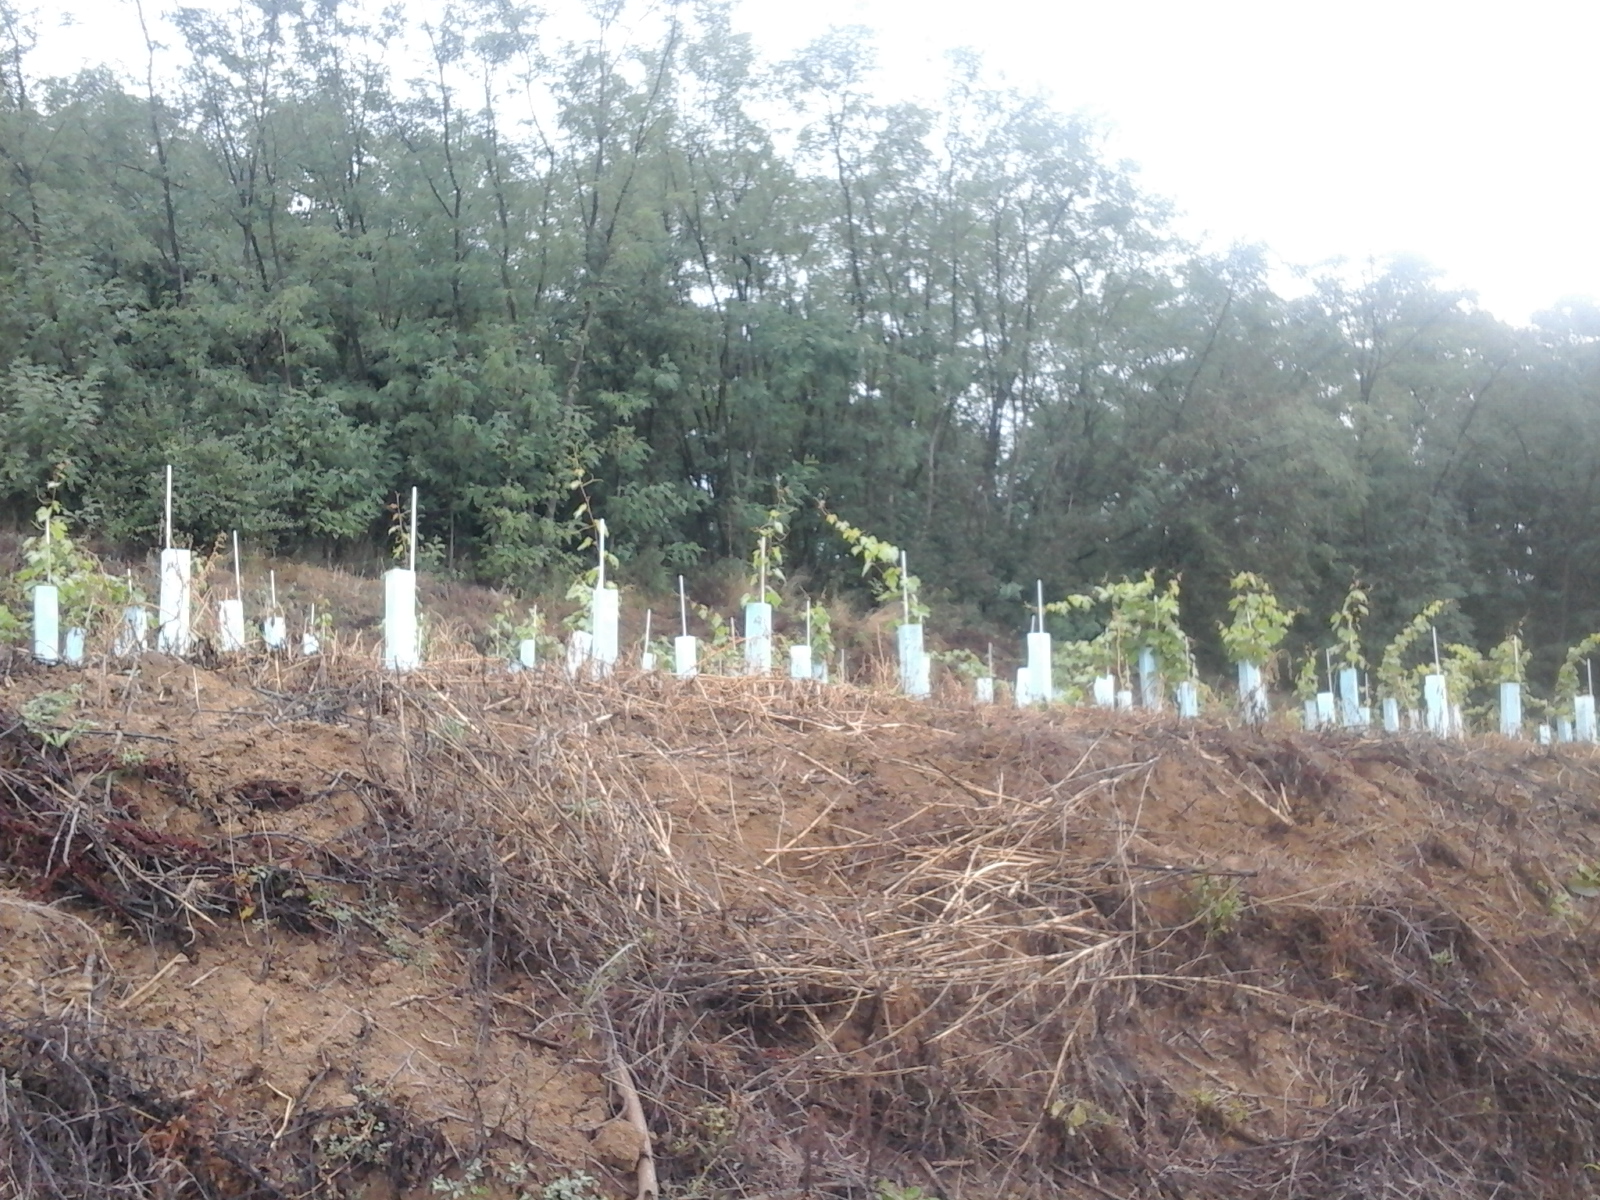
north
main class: Cropland
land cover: Vineyards
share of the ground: > 75 %
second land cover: Other bare soil
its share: > 75 %
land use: Agriculture (excluding fallow land and kitchen gardens)
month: September
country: RO
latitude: 47.2398
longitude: 22.6204
